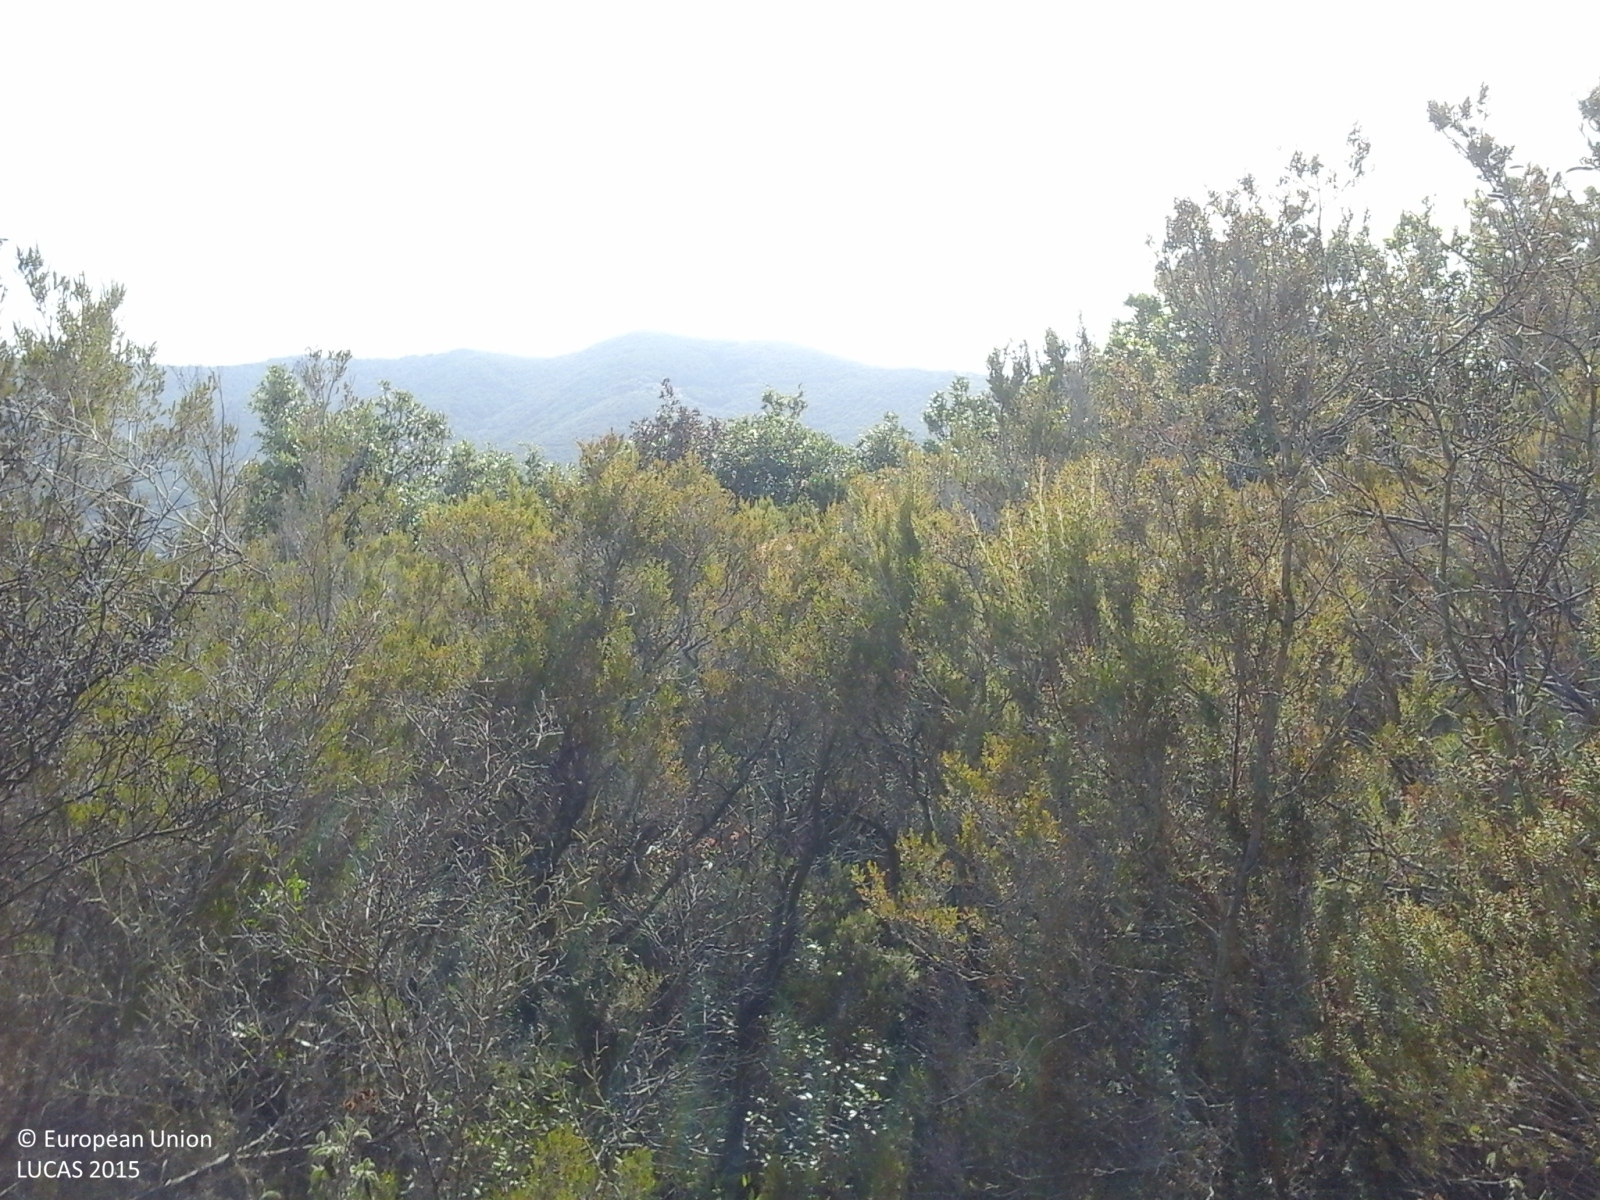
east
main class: Woodland
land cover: Other mixed woodland
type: broadleaved evergreen forest
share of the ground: > 75 %
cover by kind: broadleaved forest trees 75 %, coniferous forest trees 25 %
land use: Semi-natural and natural areas not in use
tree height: < 5 m
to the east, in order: Other mixed woodland
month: July
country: IT
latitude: 42.7982
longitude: 10.2559
